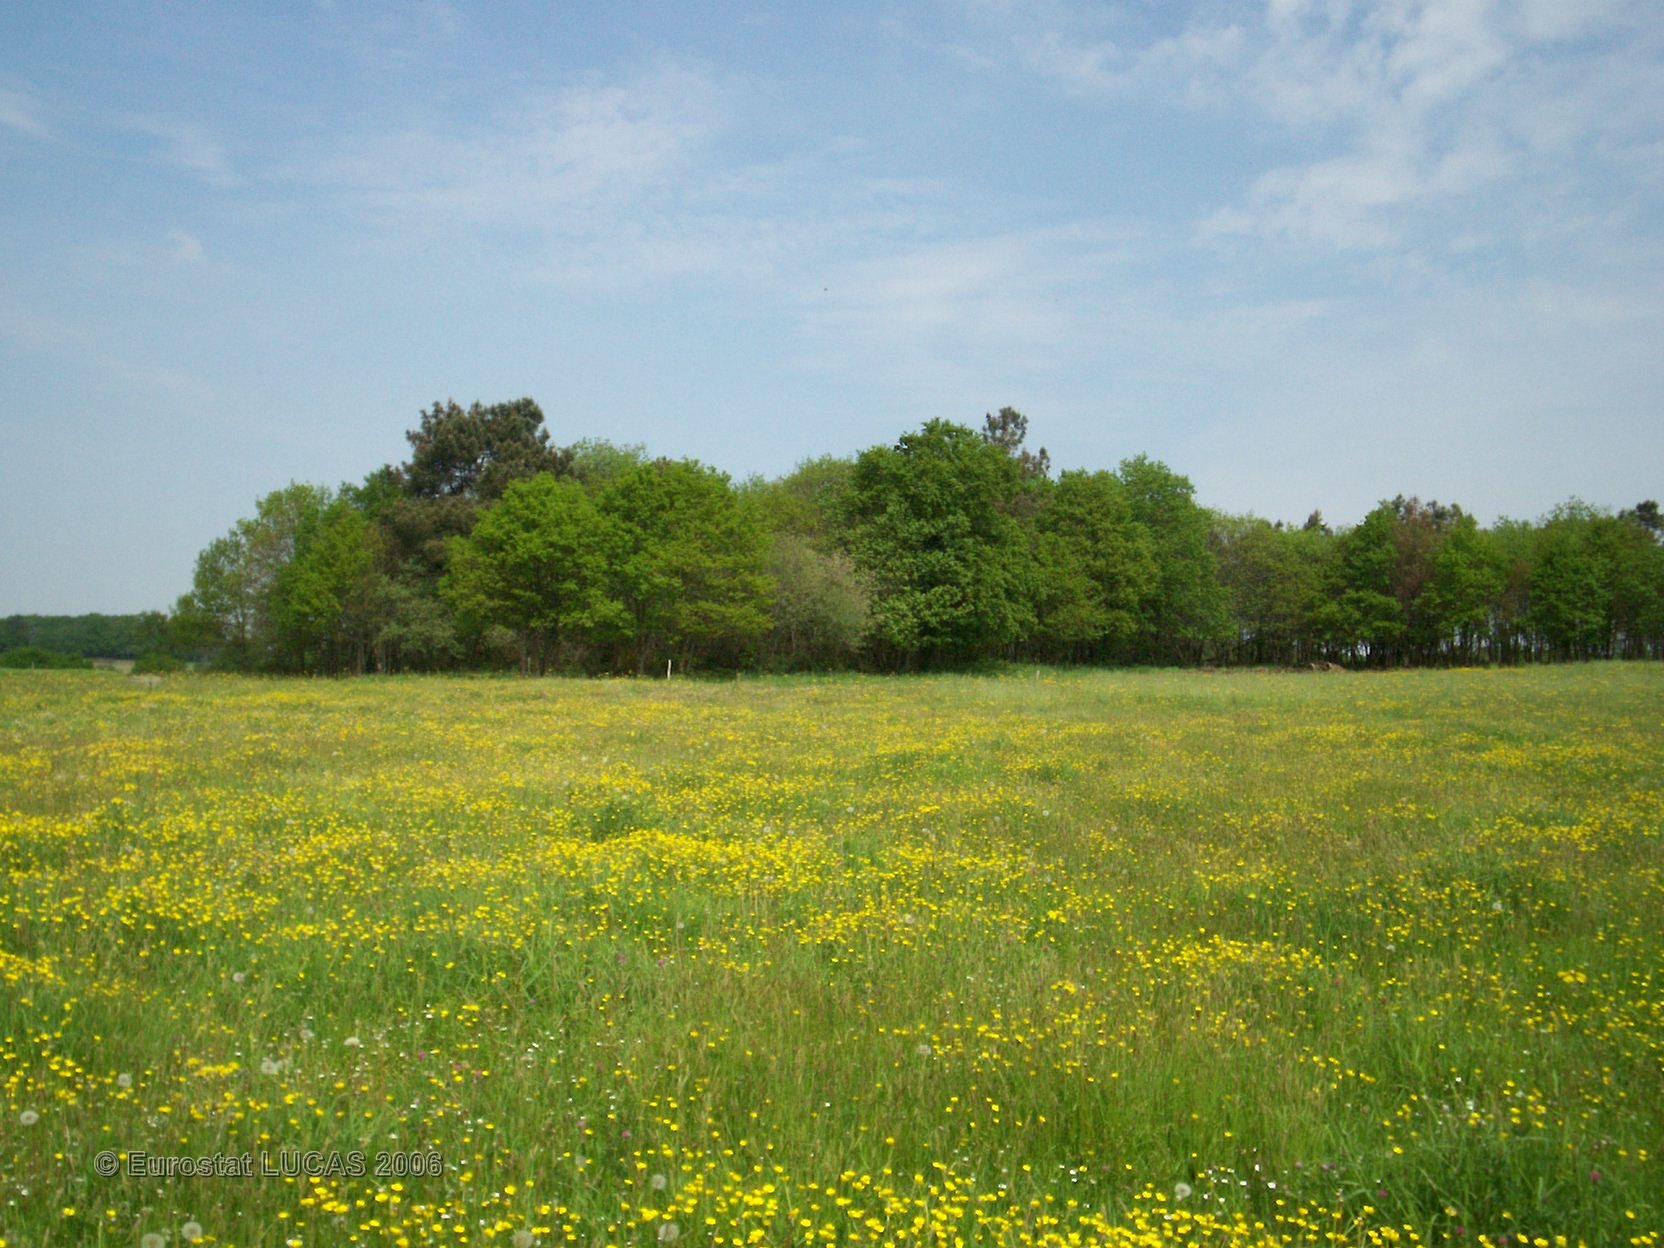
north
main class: Grassland
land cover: Grassland without tree/shrub cover
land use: Agriculture (excluding fallow land and kitchen gardens)
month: May
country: FR
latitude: 47.7752
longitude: -2.2383
